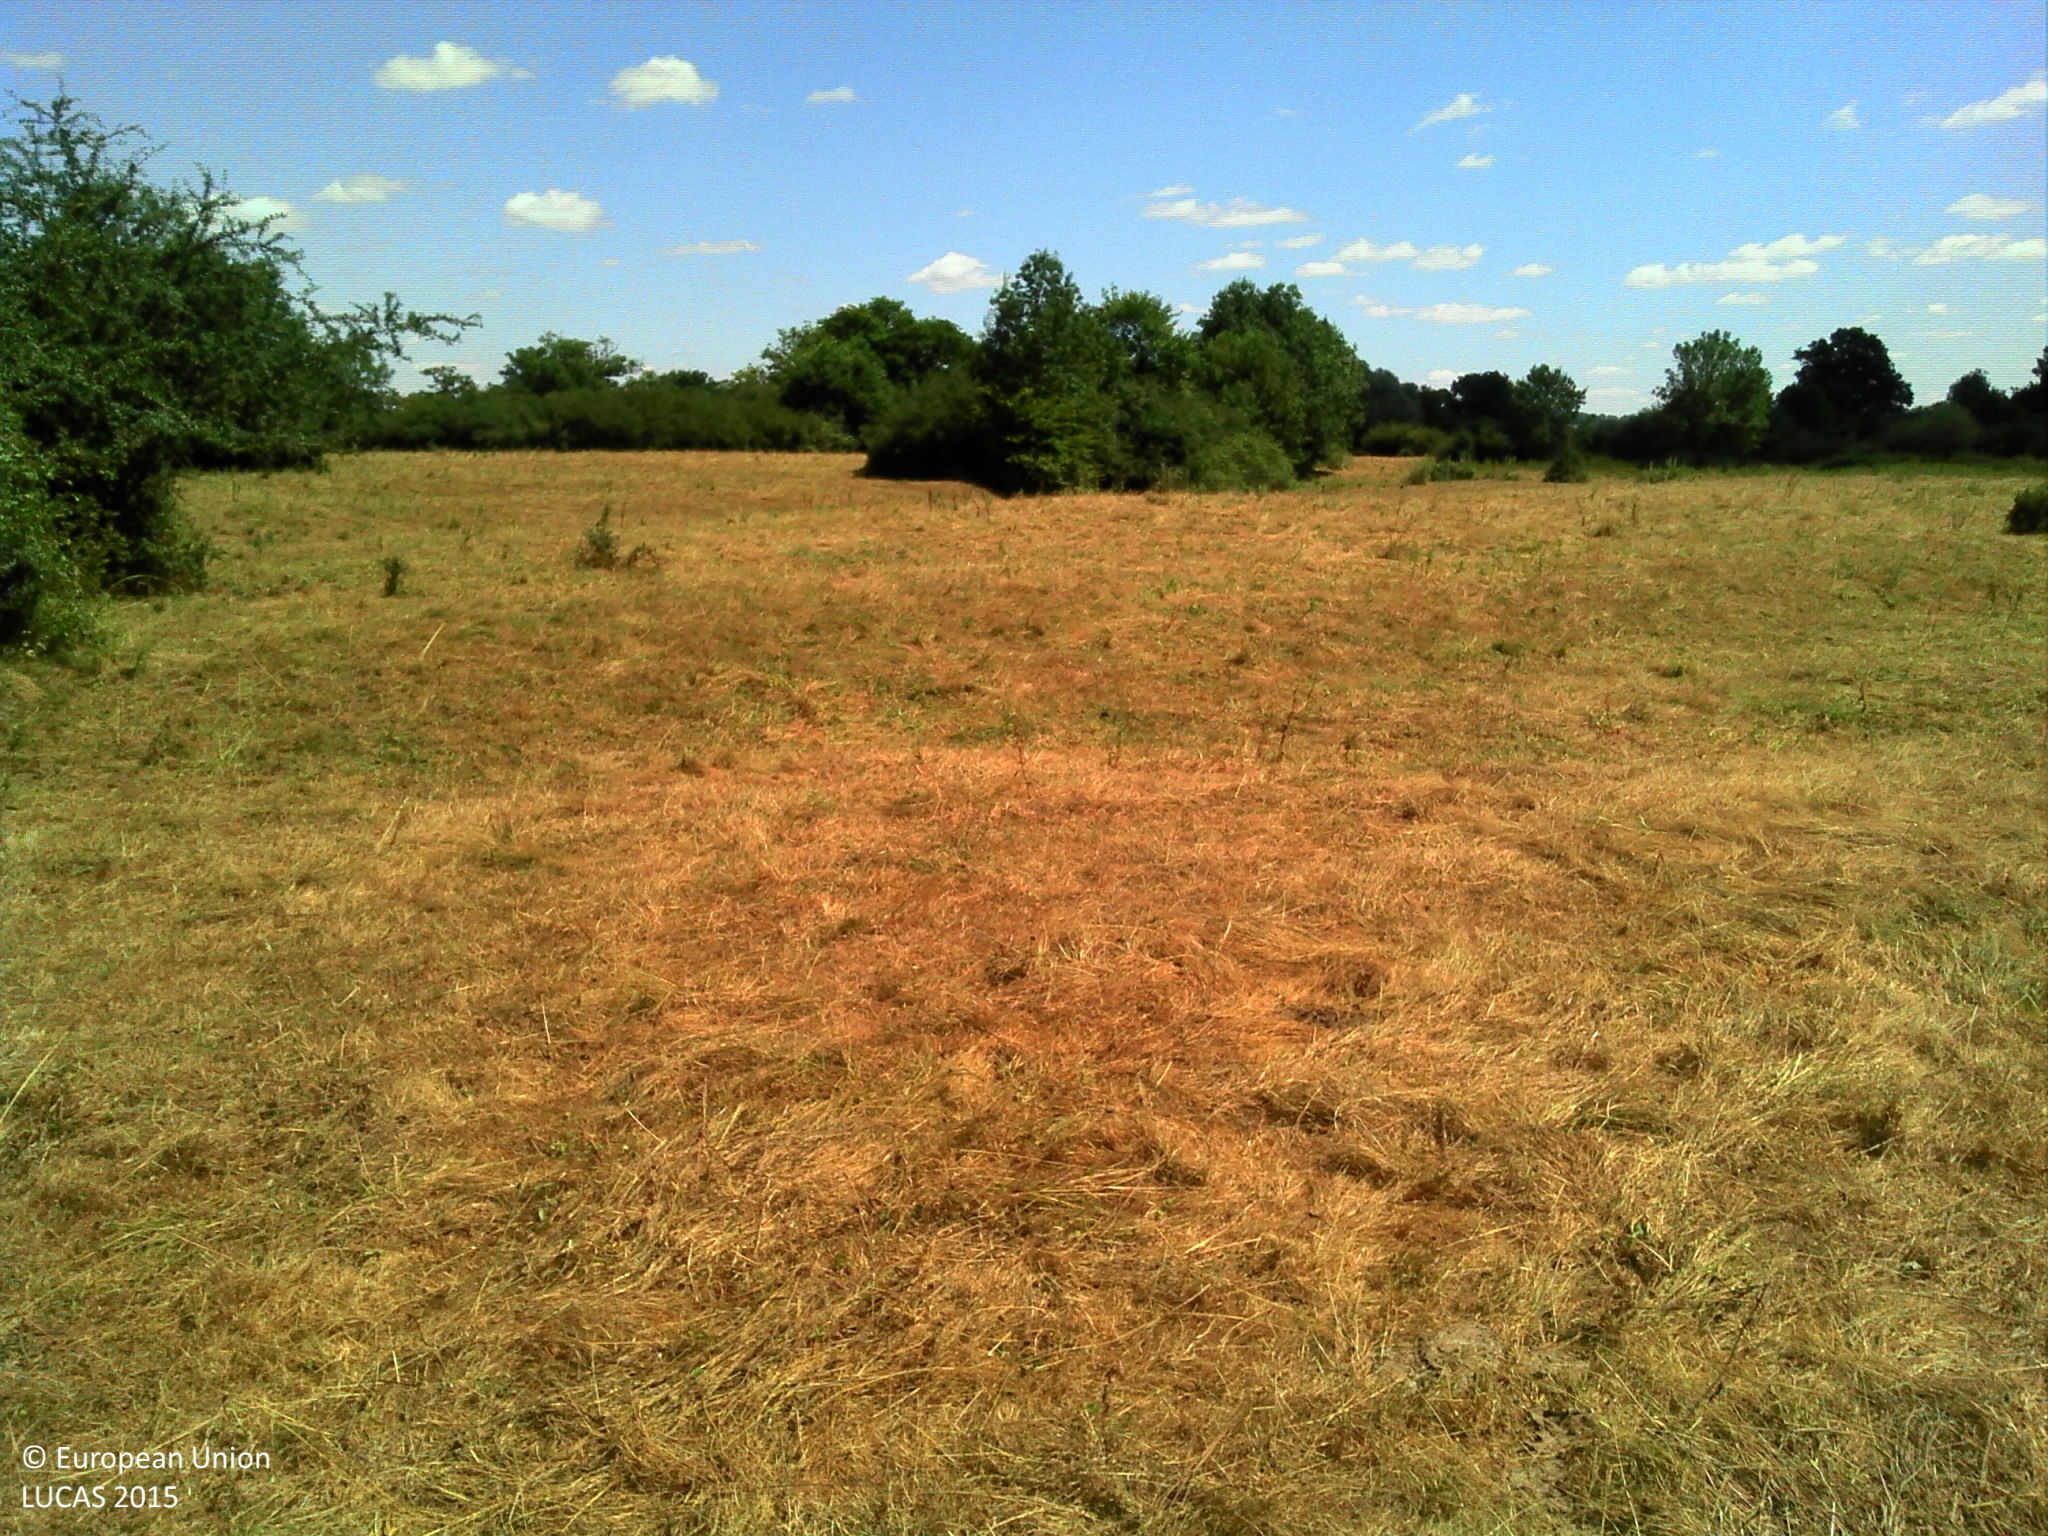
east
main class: Grassland
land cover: Grassland without tree/shrub cover
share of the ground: > 75 %
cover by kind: herbaceous plants 95 %, shrubs 5 %
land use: Agriculture (excluding fallow land and kitchen gardens)
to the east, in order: Grassland without tree/shrub cover; Single bushes/trees; Fences; Broadleaved woodland; Rivers and streams; Grassland without tree/shrub cover
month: July
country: FR
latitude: 46.8645
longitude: 3.6097
